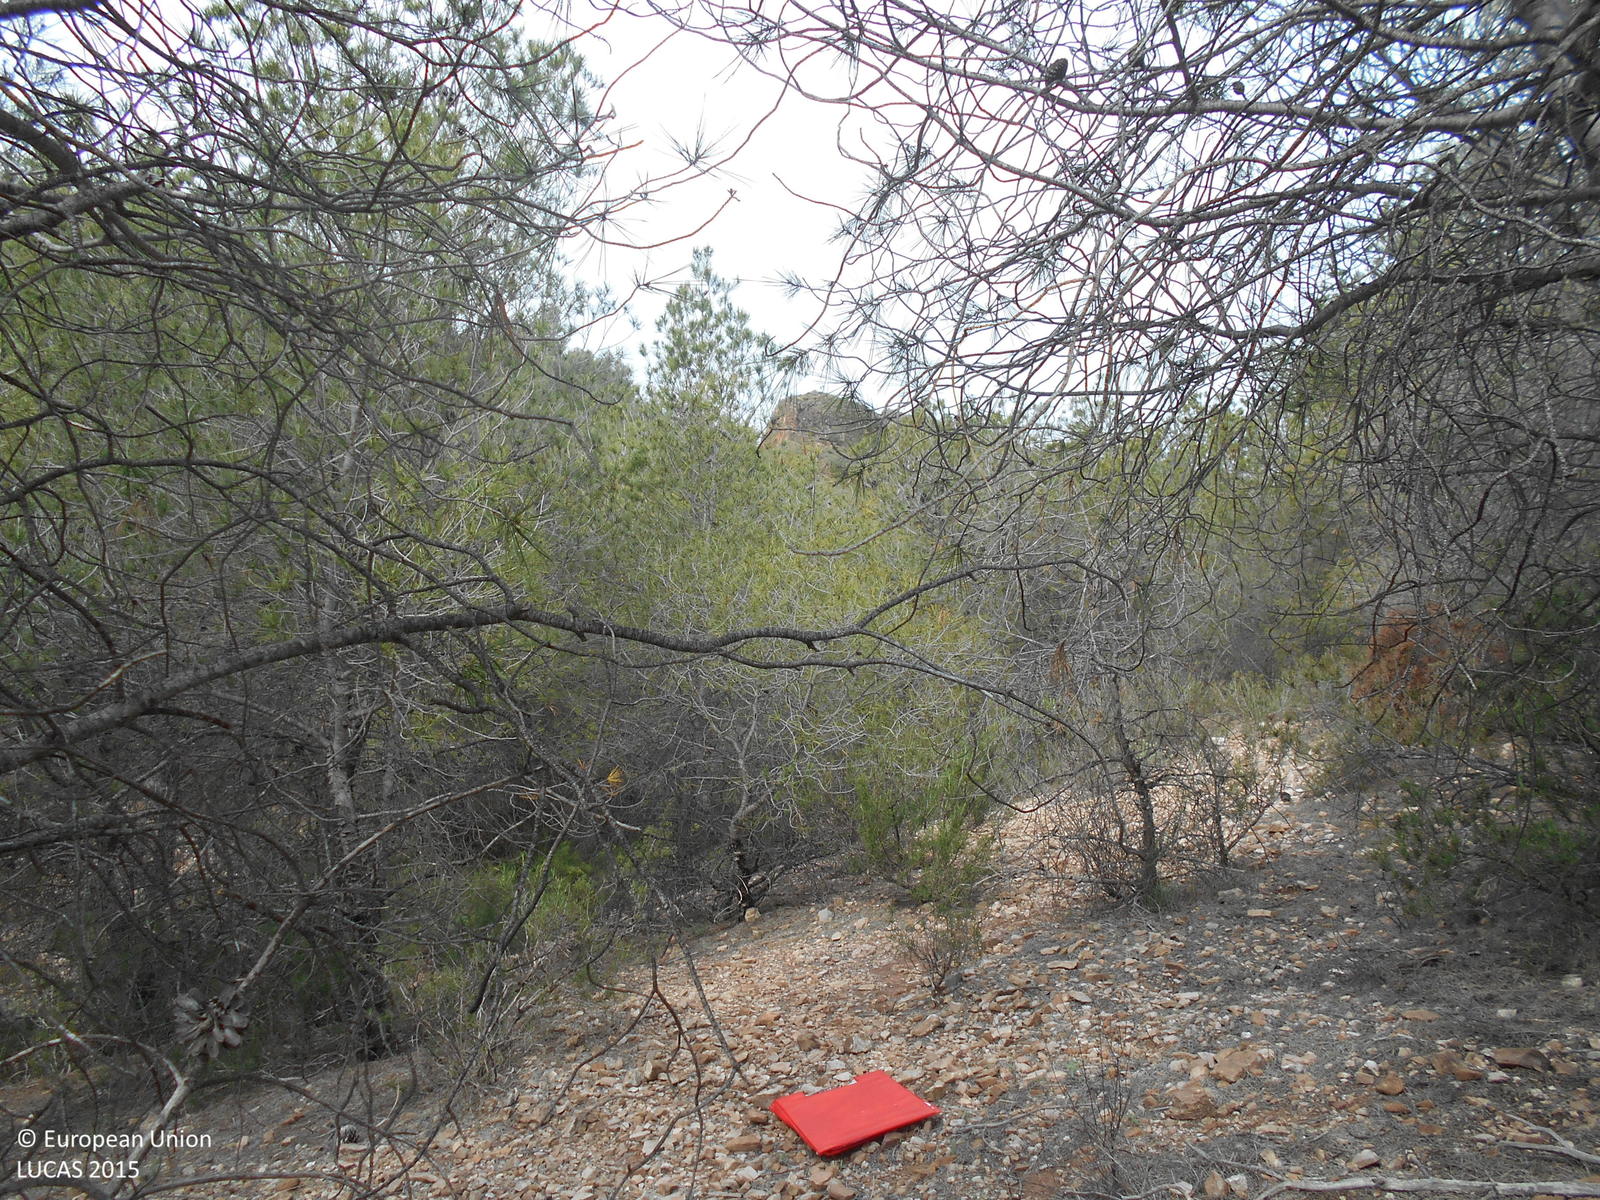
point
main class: Woodland
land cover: Pine dominated coniferous woodland
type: coniferous forest of the mediterranean region
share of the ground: 50 - 75 %
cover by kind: coniferous forest trees 70 %, unconsolidated bare surface 20 %, shrubs 10 %
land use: Semi-natural and natural areas not in use
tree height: > 5 m
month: April
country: ES
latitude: 37.7910
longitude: -1.5549
